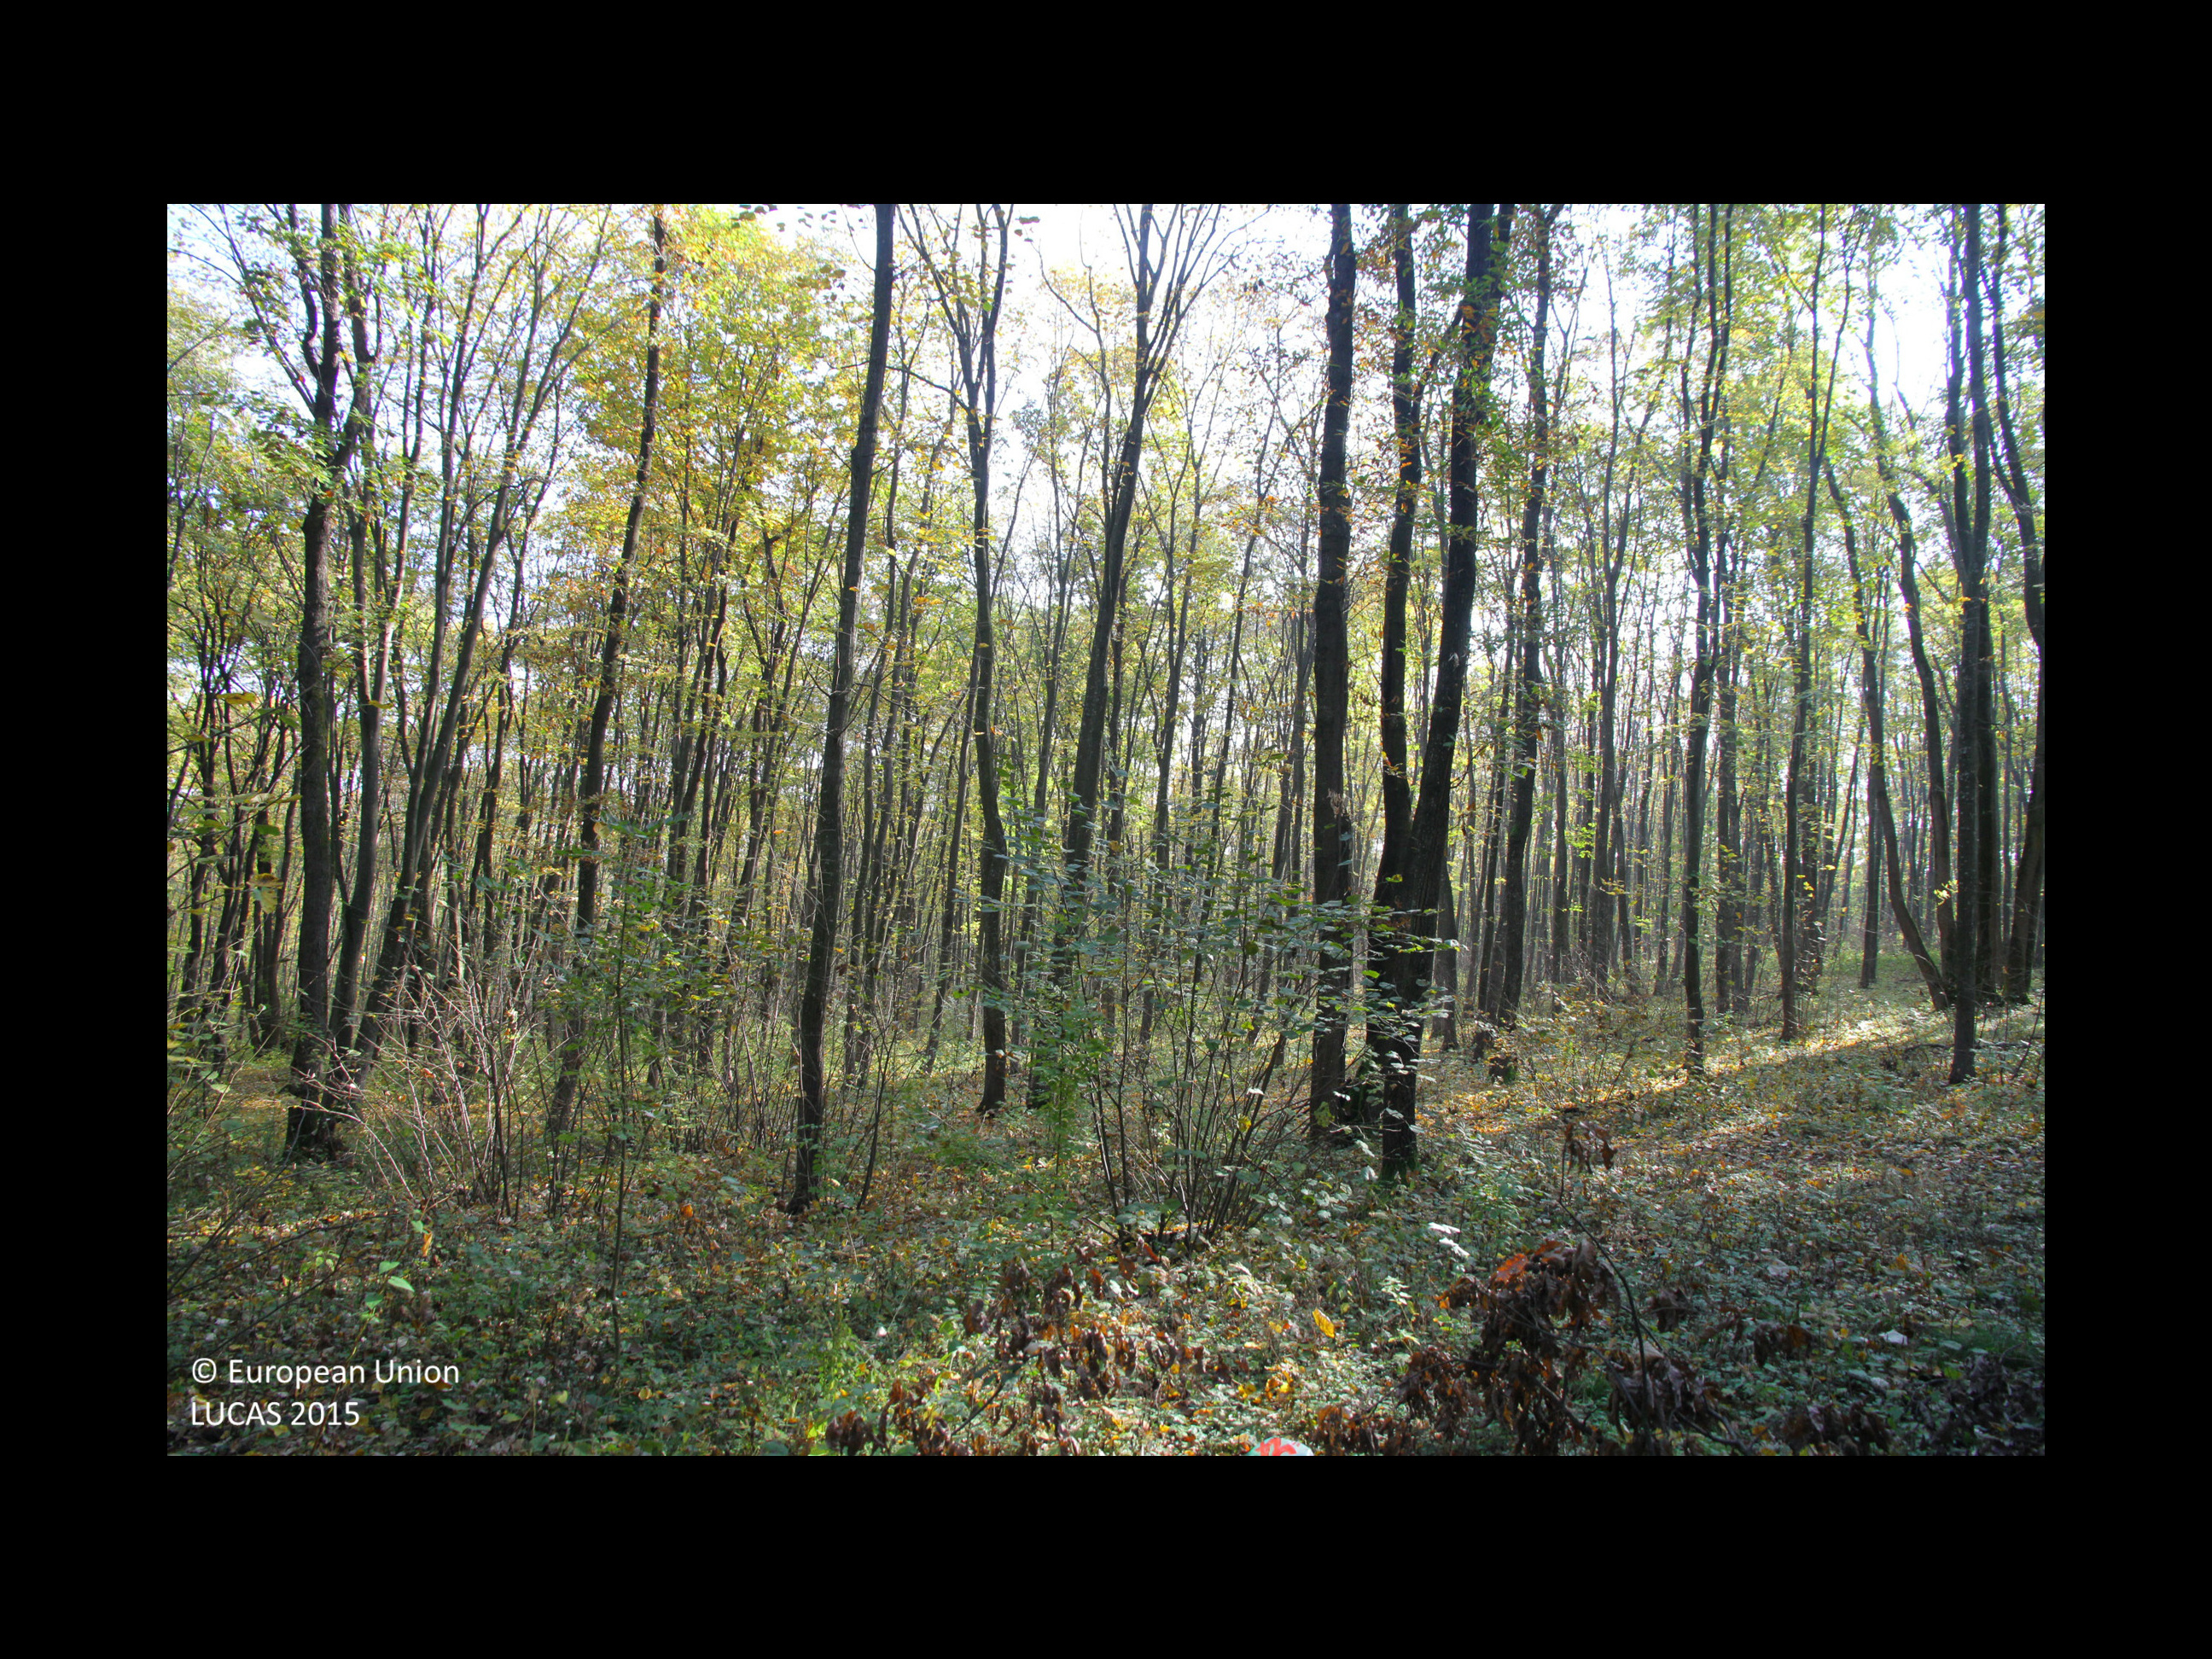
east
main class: Woodland
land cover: Broadleaved woodland
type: beech forest
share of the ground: > 75 %
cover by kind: broadleaved forest trees 90 %, herbaceous plants 5 %, unconsolidated bare surface 5 %
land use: Forestry
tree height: > 5 m
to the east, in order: Broadleaved woodland; Tracks; Broadleaved woodland; Ditches and canals; Broadleaved woodland
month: October
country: BG
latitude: 43.8708
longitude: 26.3443
